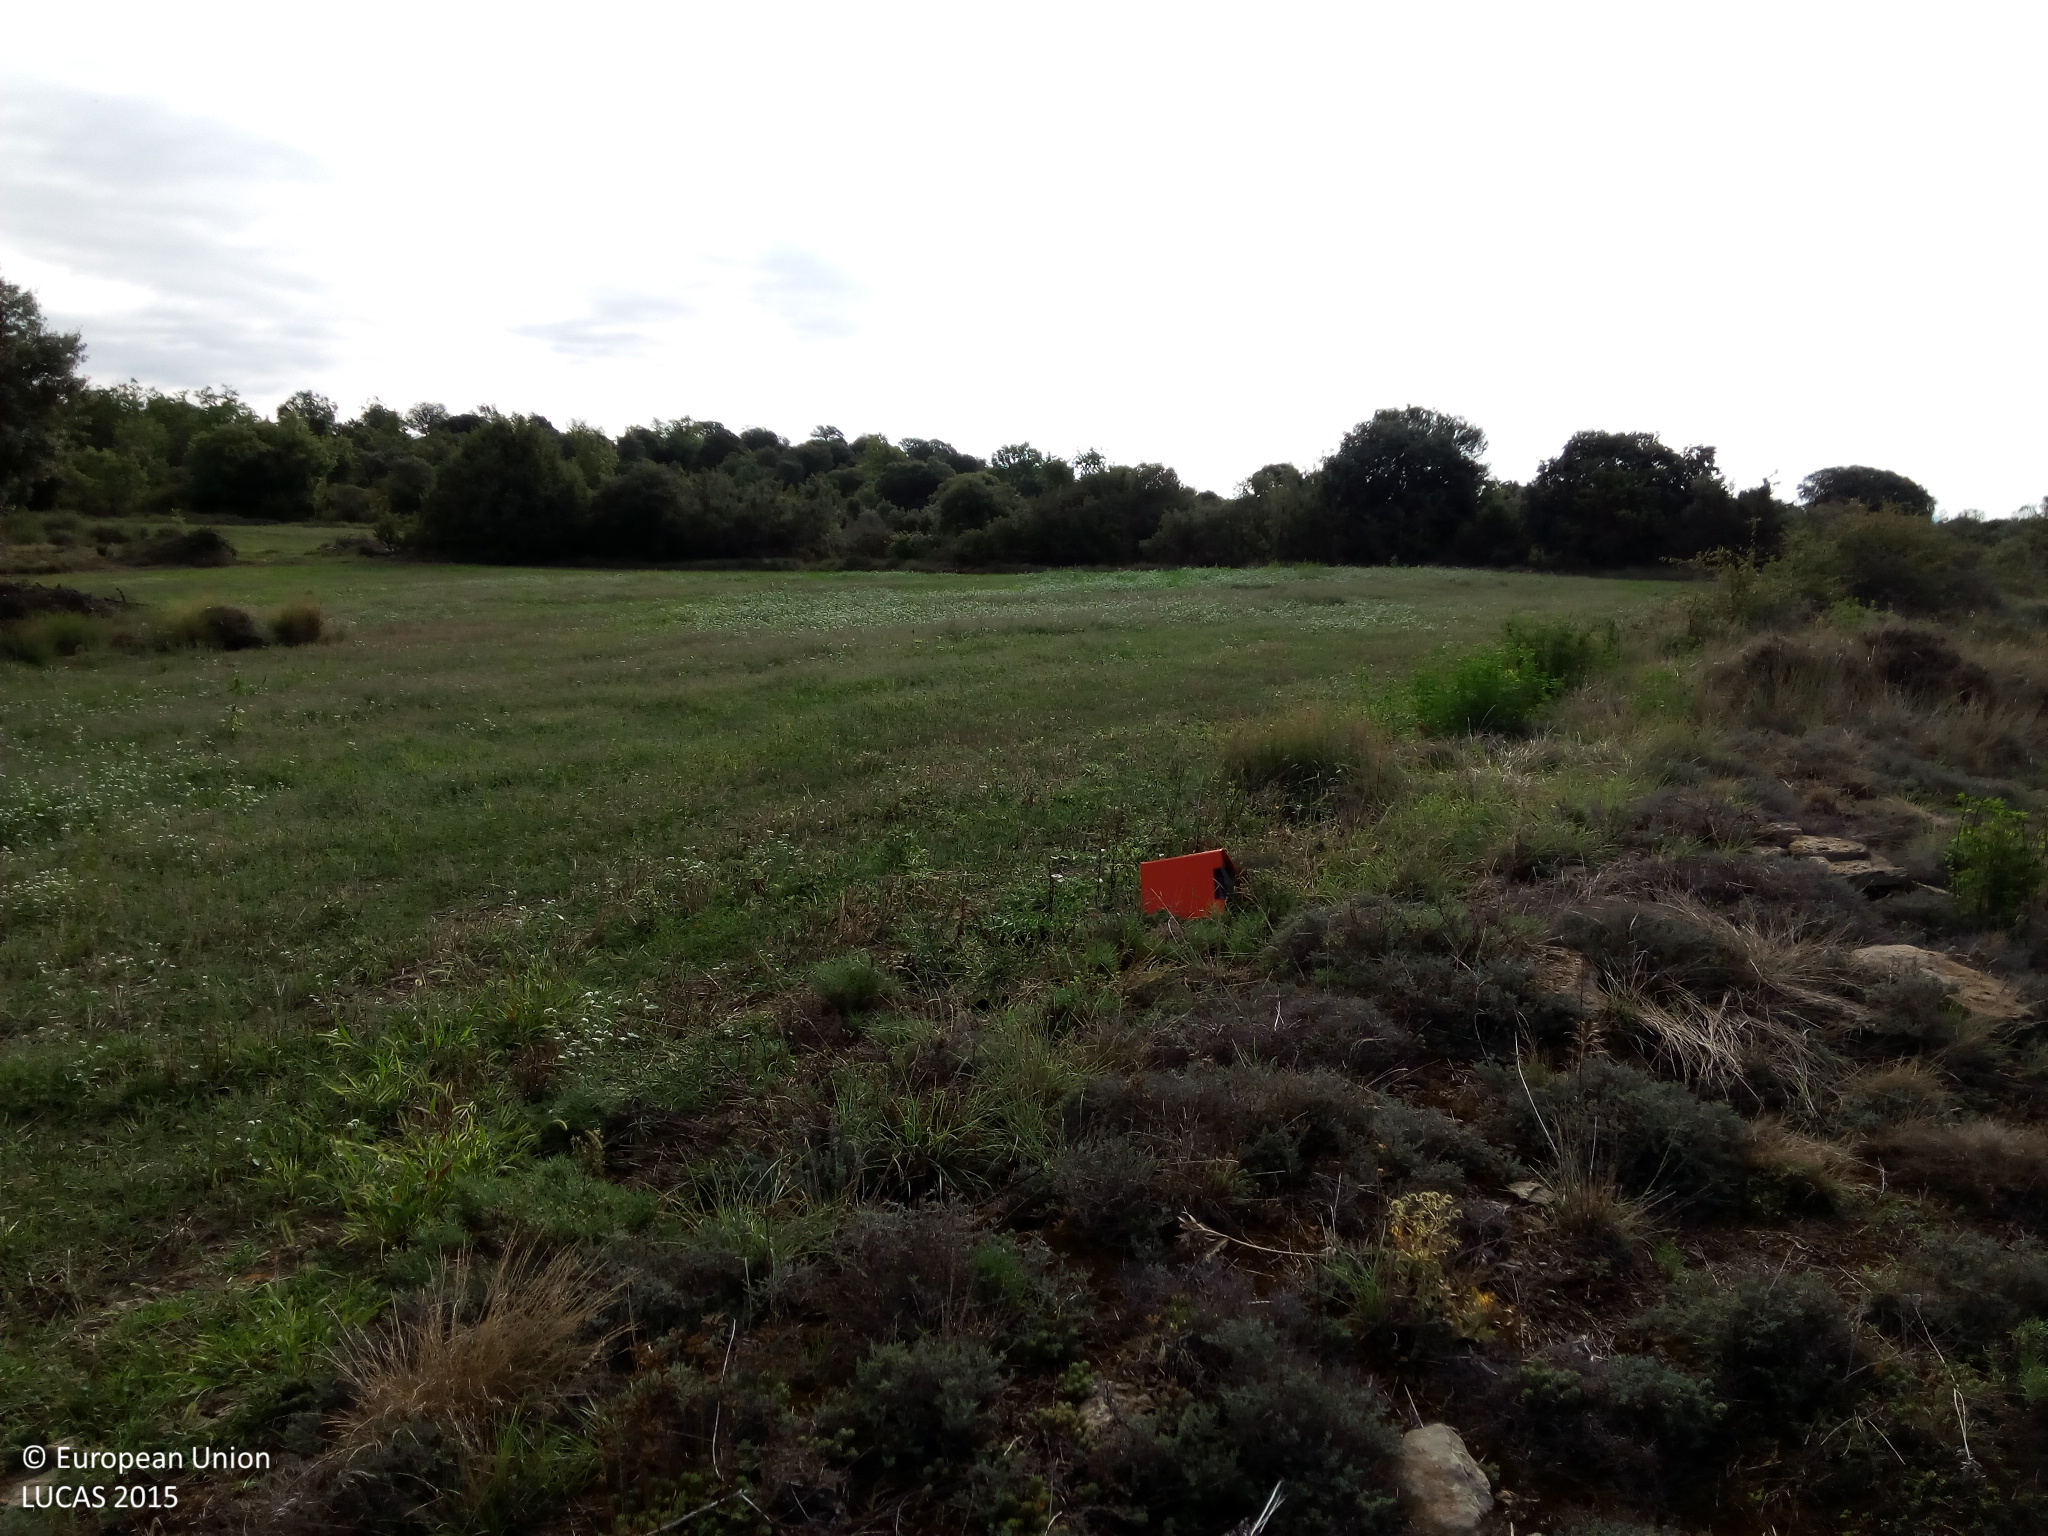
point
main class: Cropland
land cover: Barley
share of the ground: < 10 %
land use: Agriculture (excluding fallow land and kitchen gardens)
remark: Harvested field
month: August
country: ES
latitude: 42.1797
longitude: 0.6004
